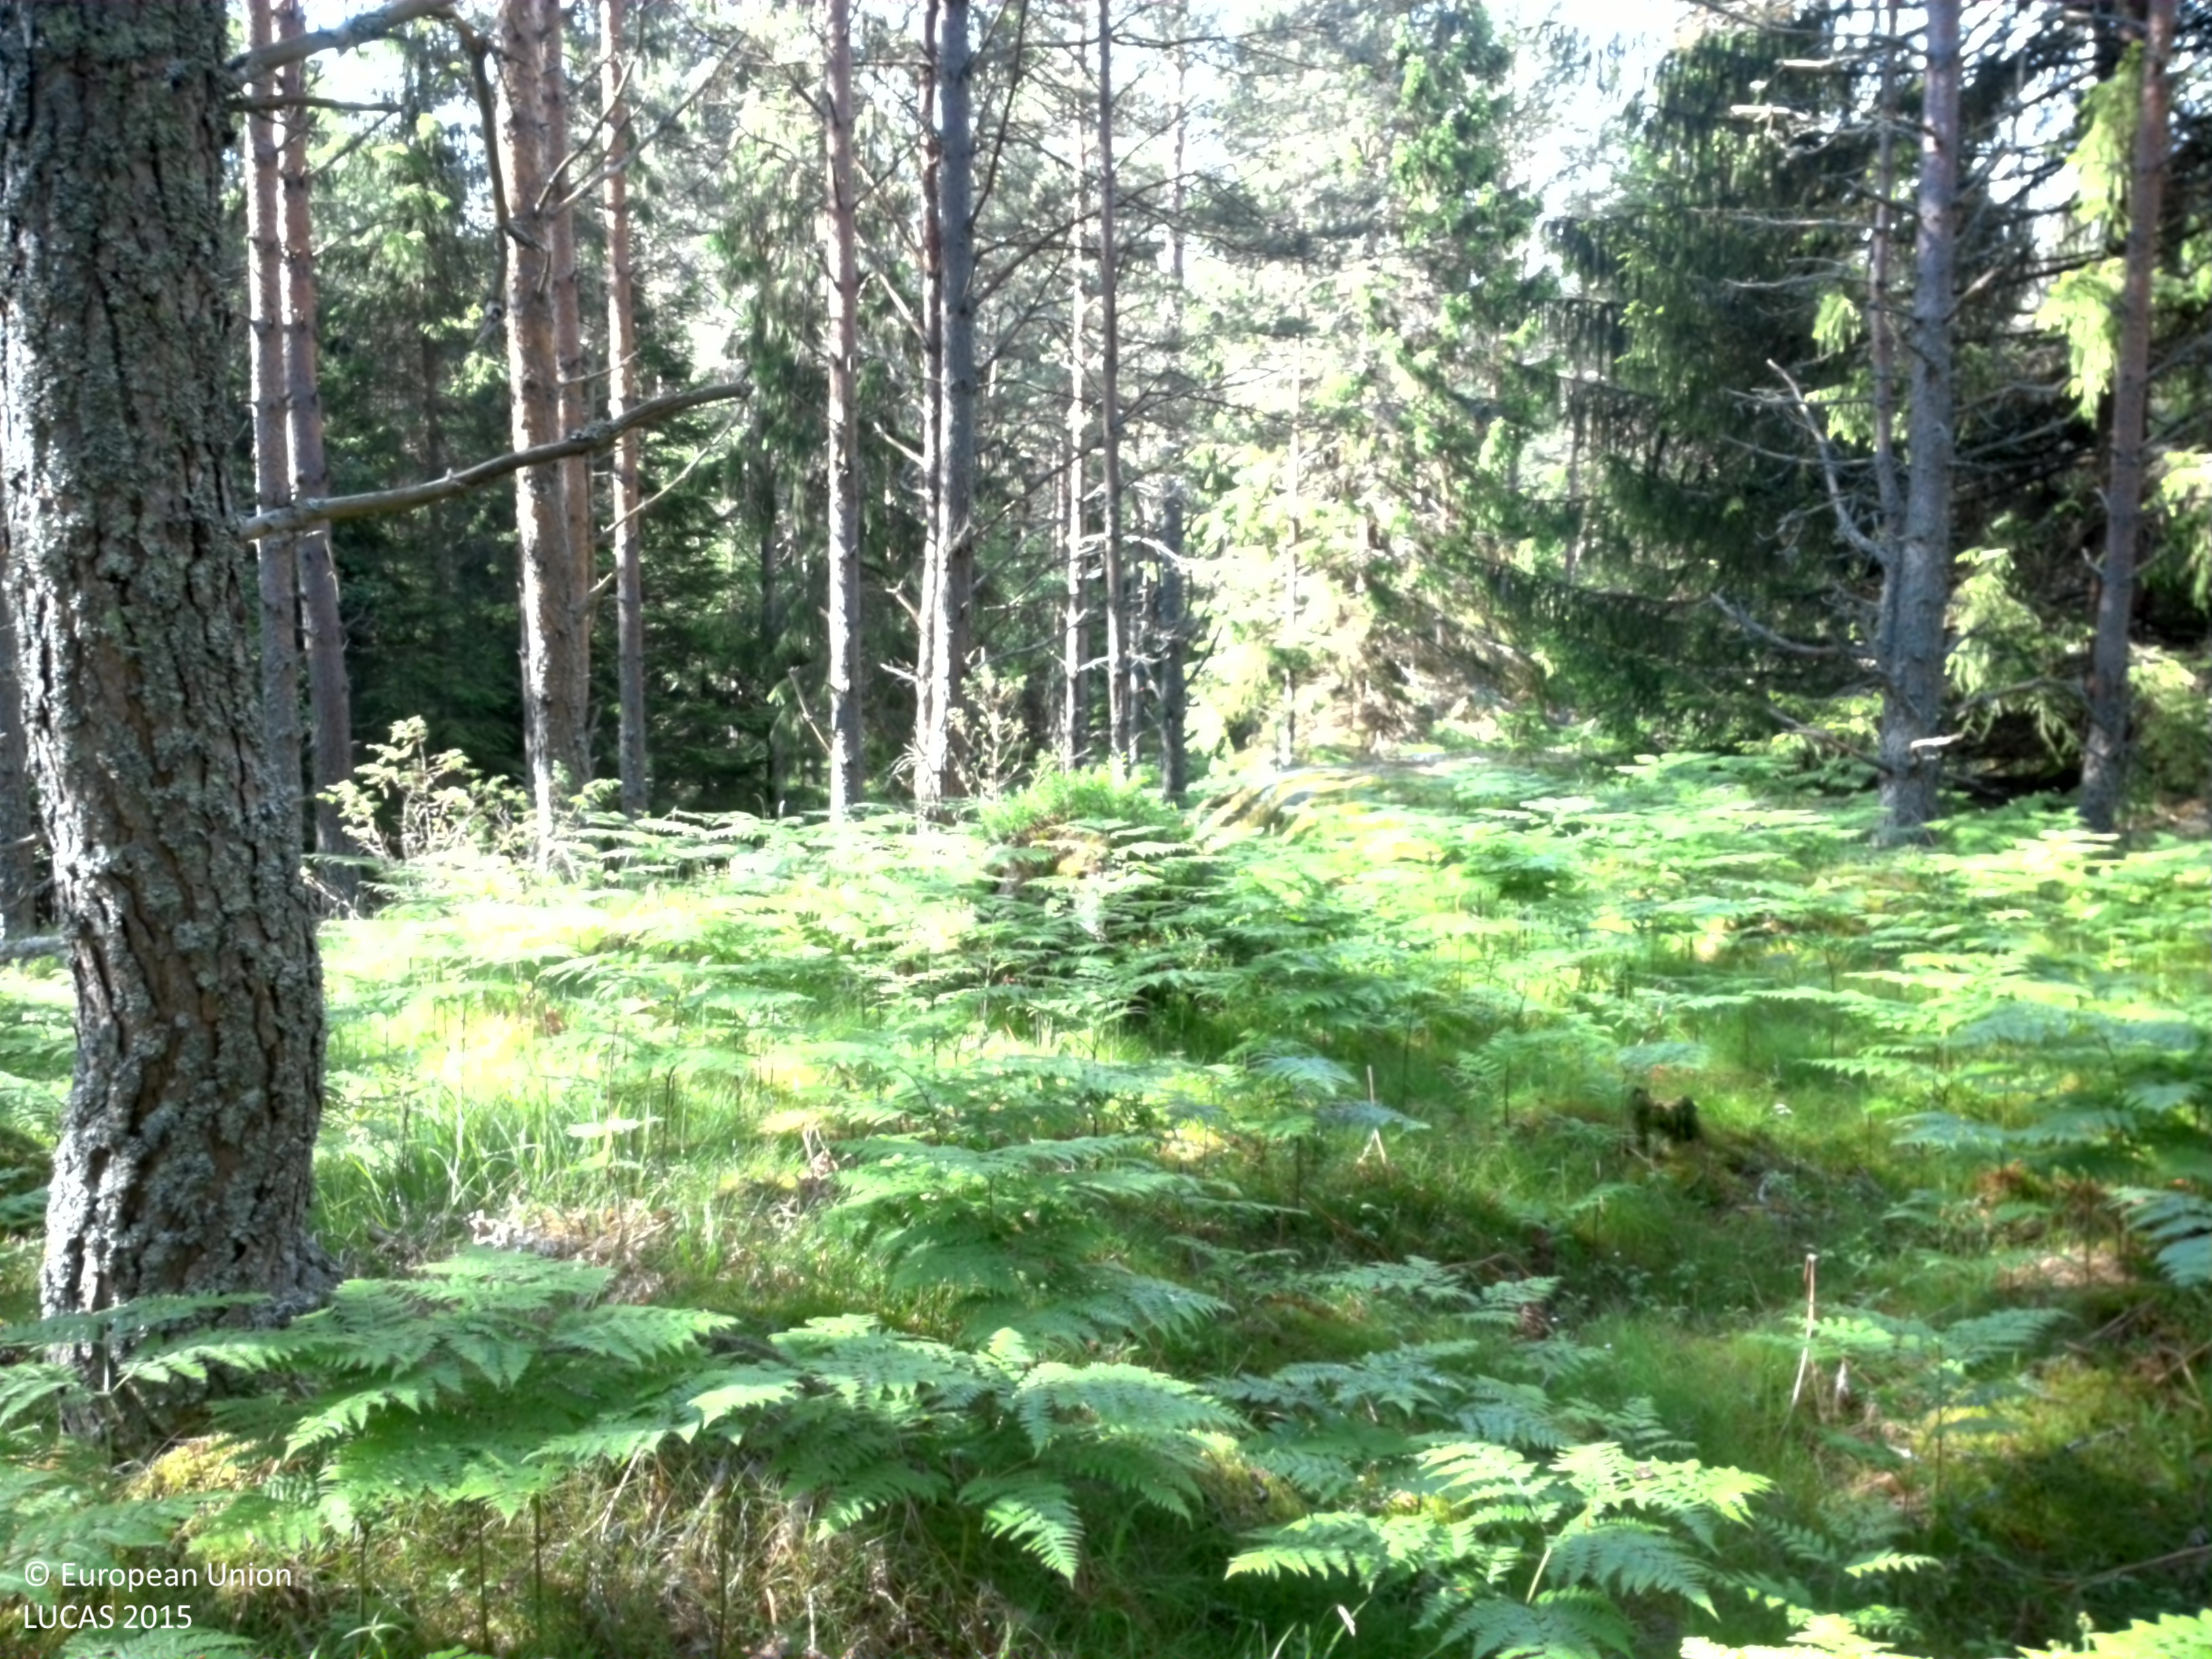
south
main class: Woodland
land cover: Pine dominated coniferous woodland
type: boreal forest
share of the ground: 25 - 50 %
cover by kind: herbaceous plants 55 %, coniferous forest trees 30 %, lichens and mosses 10 %, broadleaved forest trees 5 %
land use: Forestry
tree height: > 5 m
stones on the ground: 10 - 25 %
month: June
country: SE
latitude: 58.6126
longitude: 15.4852
